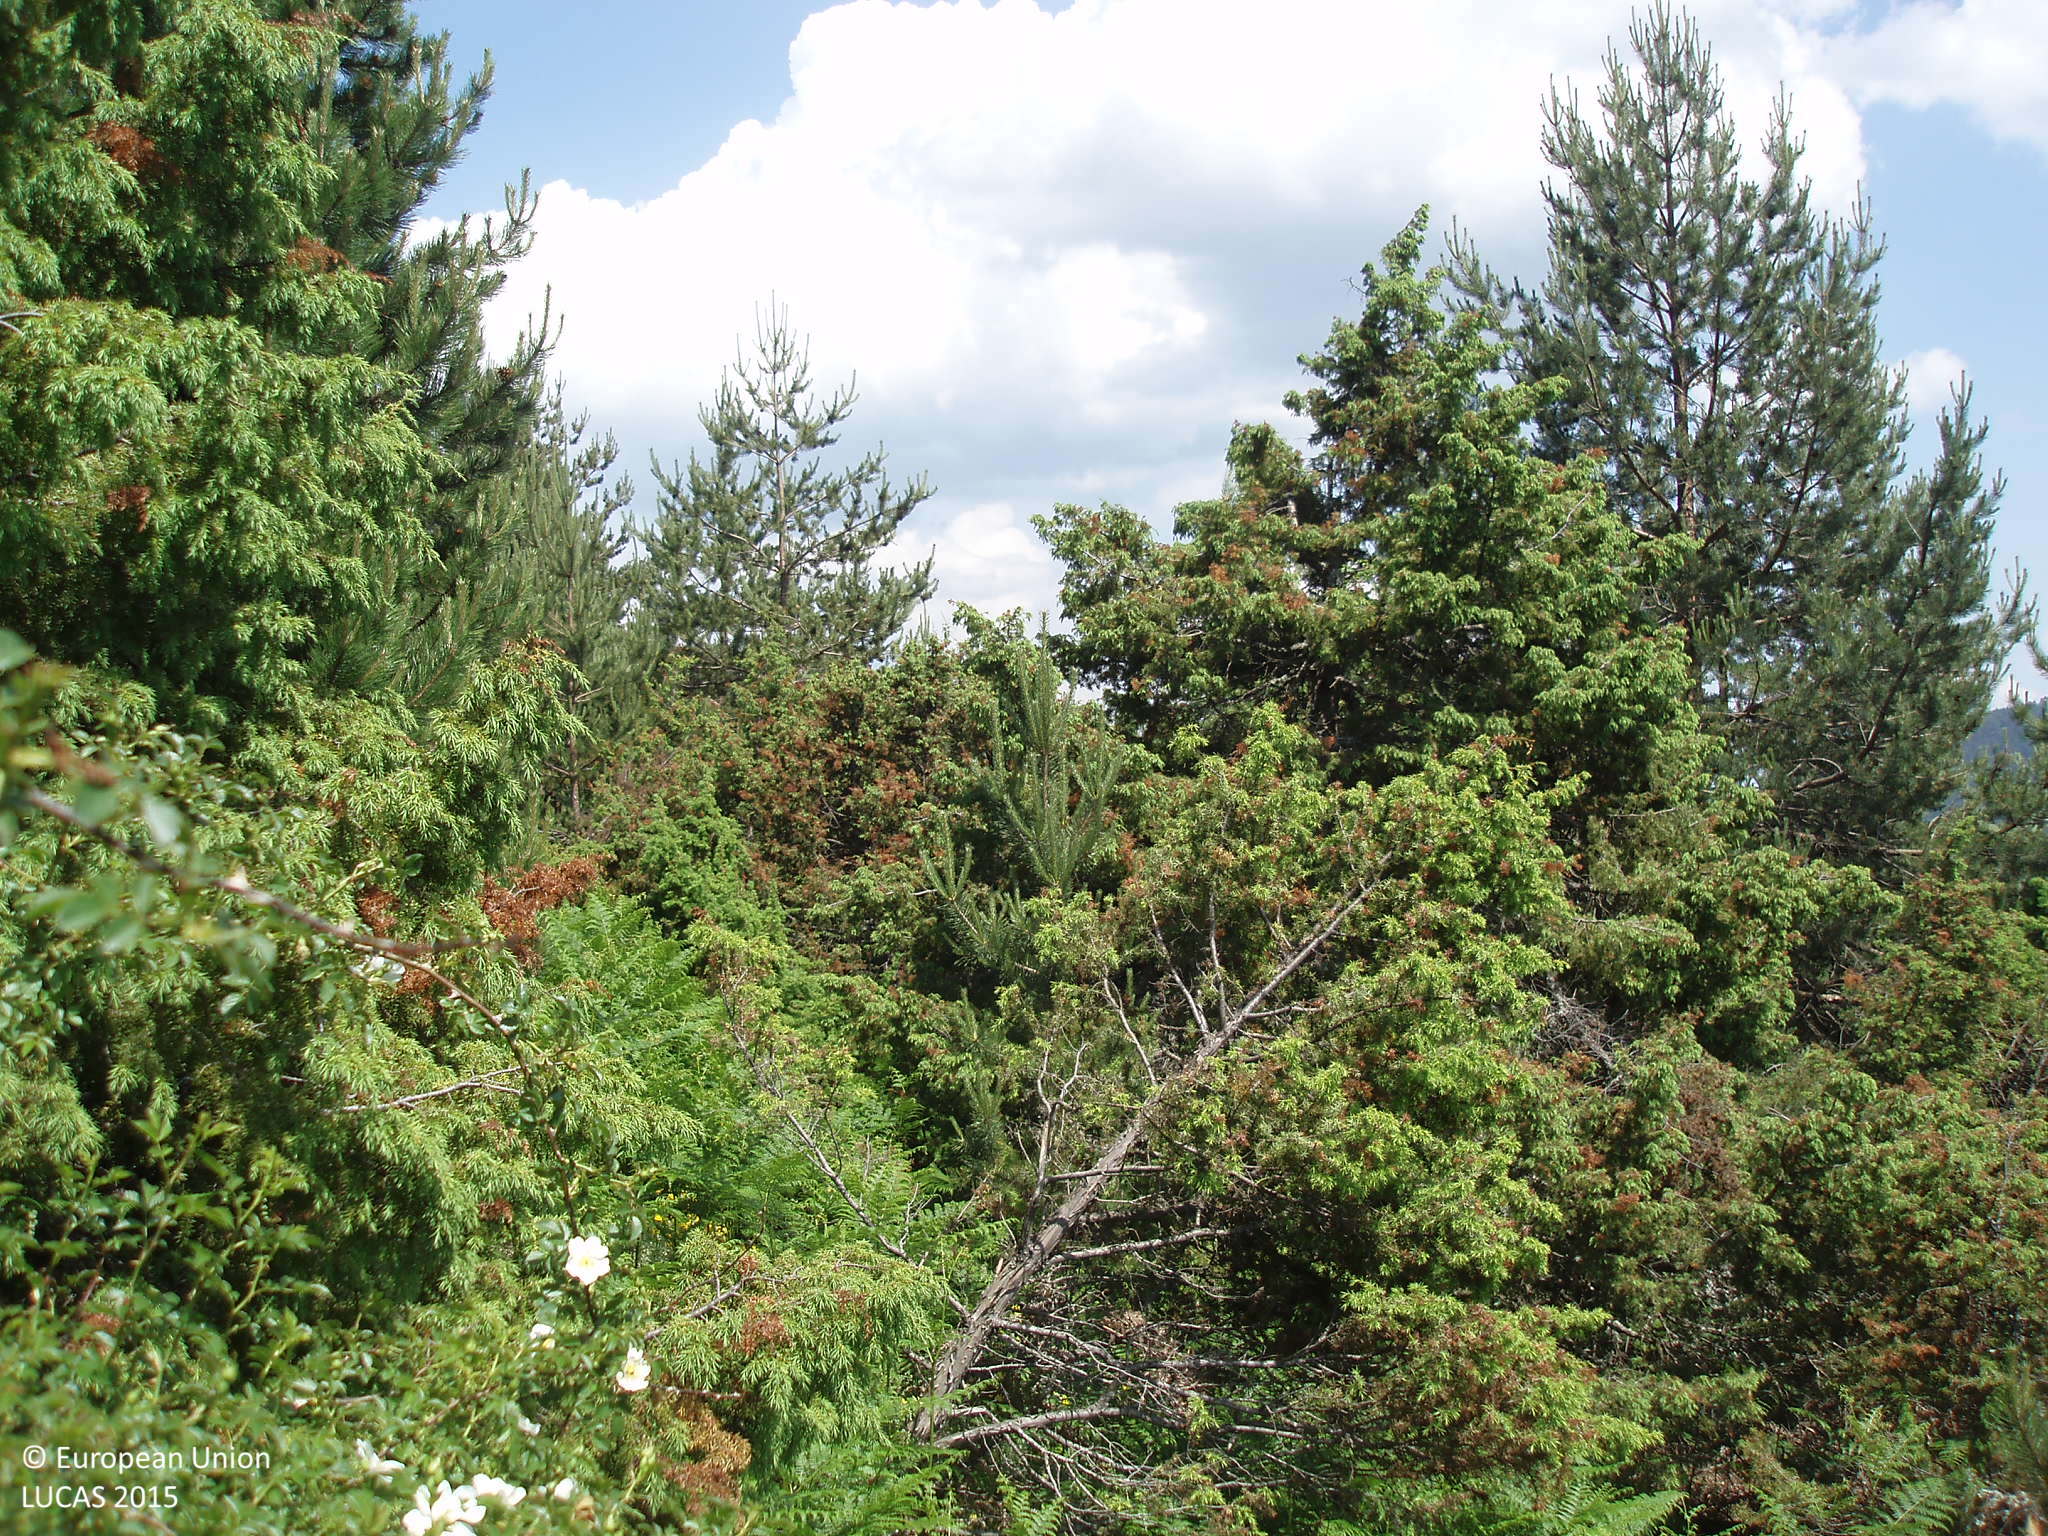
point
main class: Woodland
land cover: Other mixed woodland
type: hemiboreal forest and nemoral coniferous forest and mixed broadleaved-coniferous forest
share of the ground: > 75 %
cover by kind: coniferous forest trees 75 %, broadleaved forest trees 25 %
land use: Forestry
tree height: > 5 m
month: June
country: BG
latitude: 41.4316
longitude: 23.6558
